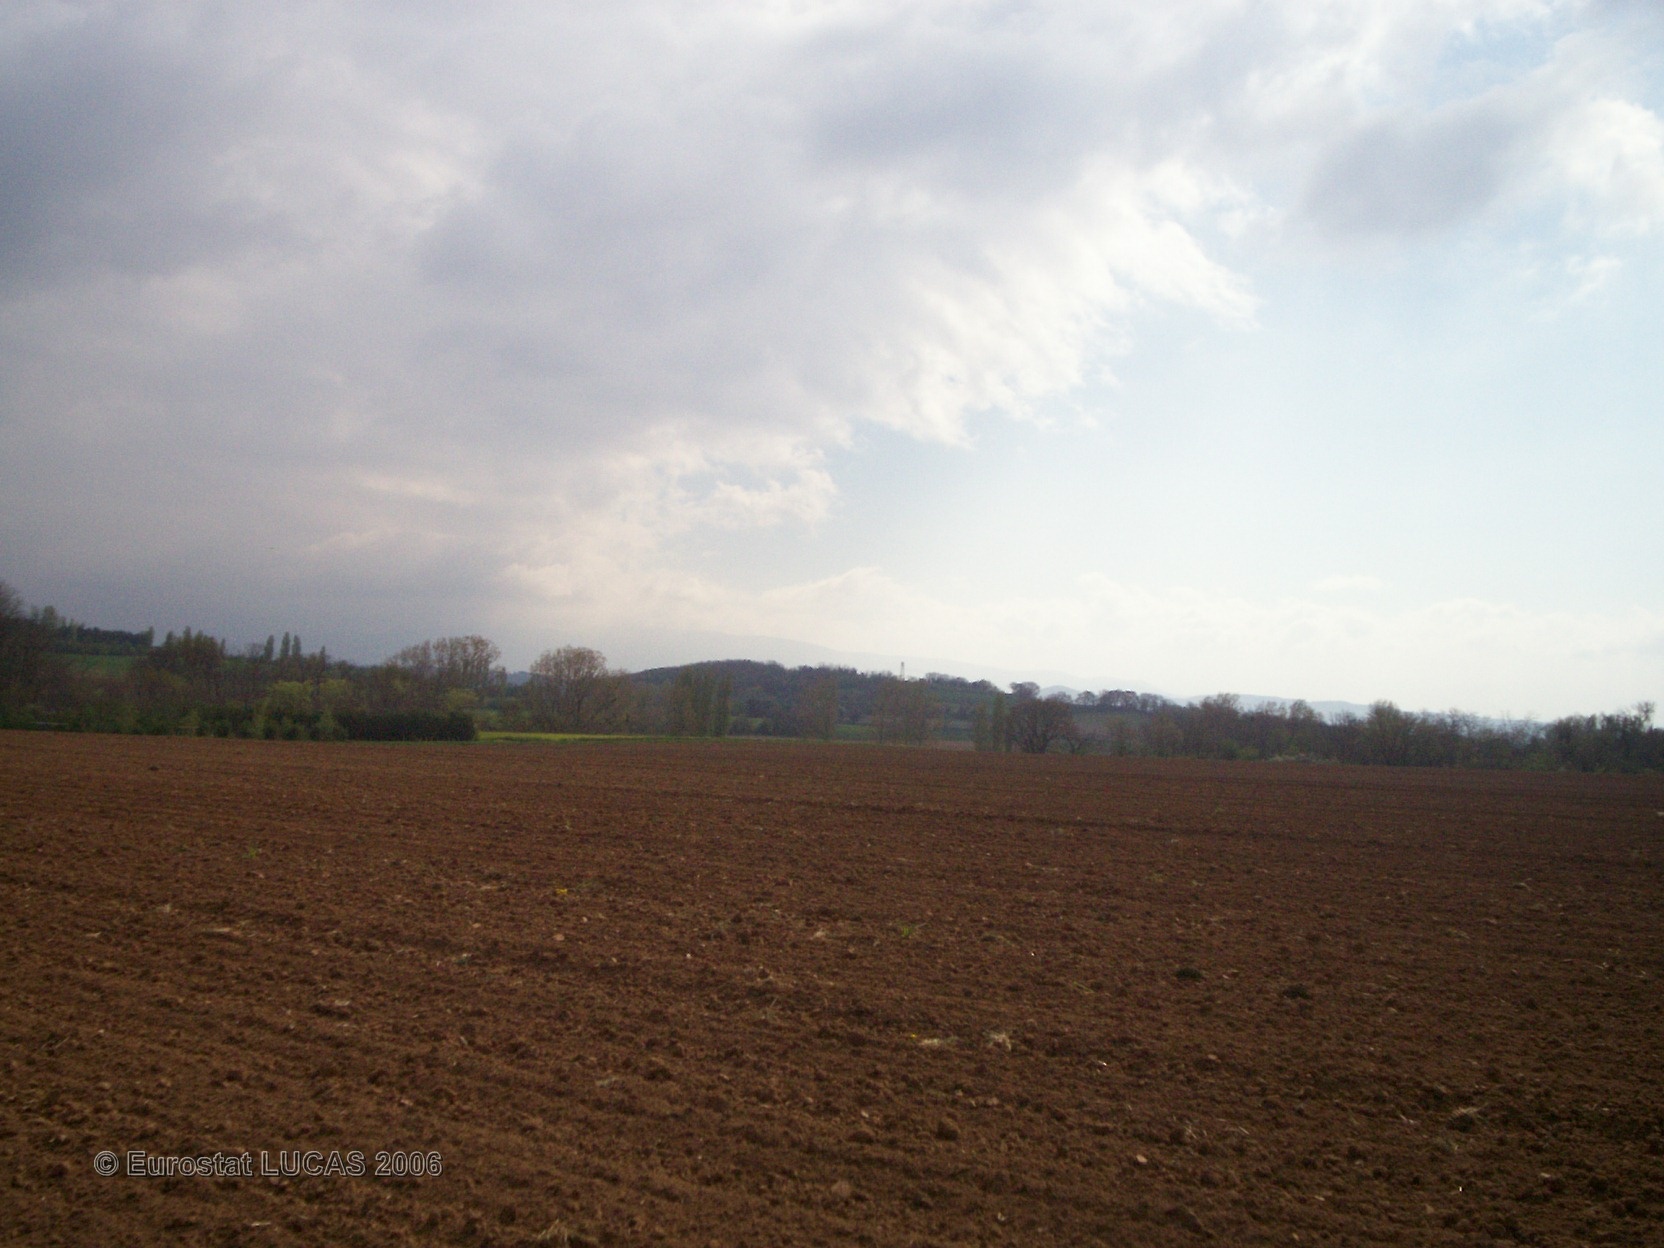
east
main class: Cropland
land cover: Maize
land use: Agriculture (excluding fallow land and kitchen gardens)
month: June
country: FR
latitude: 44.8026
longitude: 4.8859
